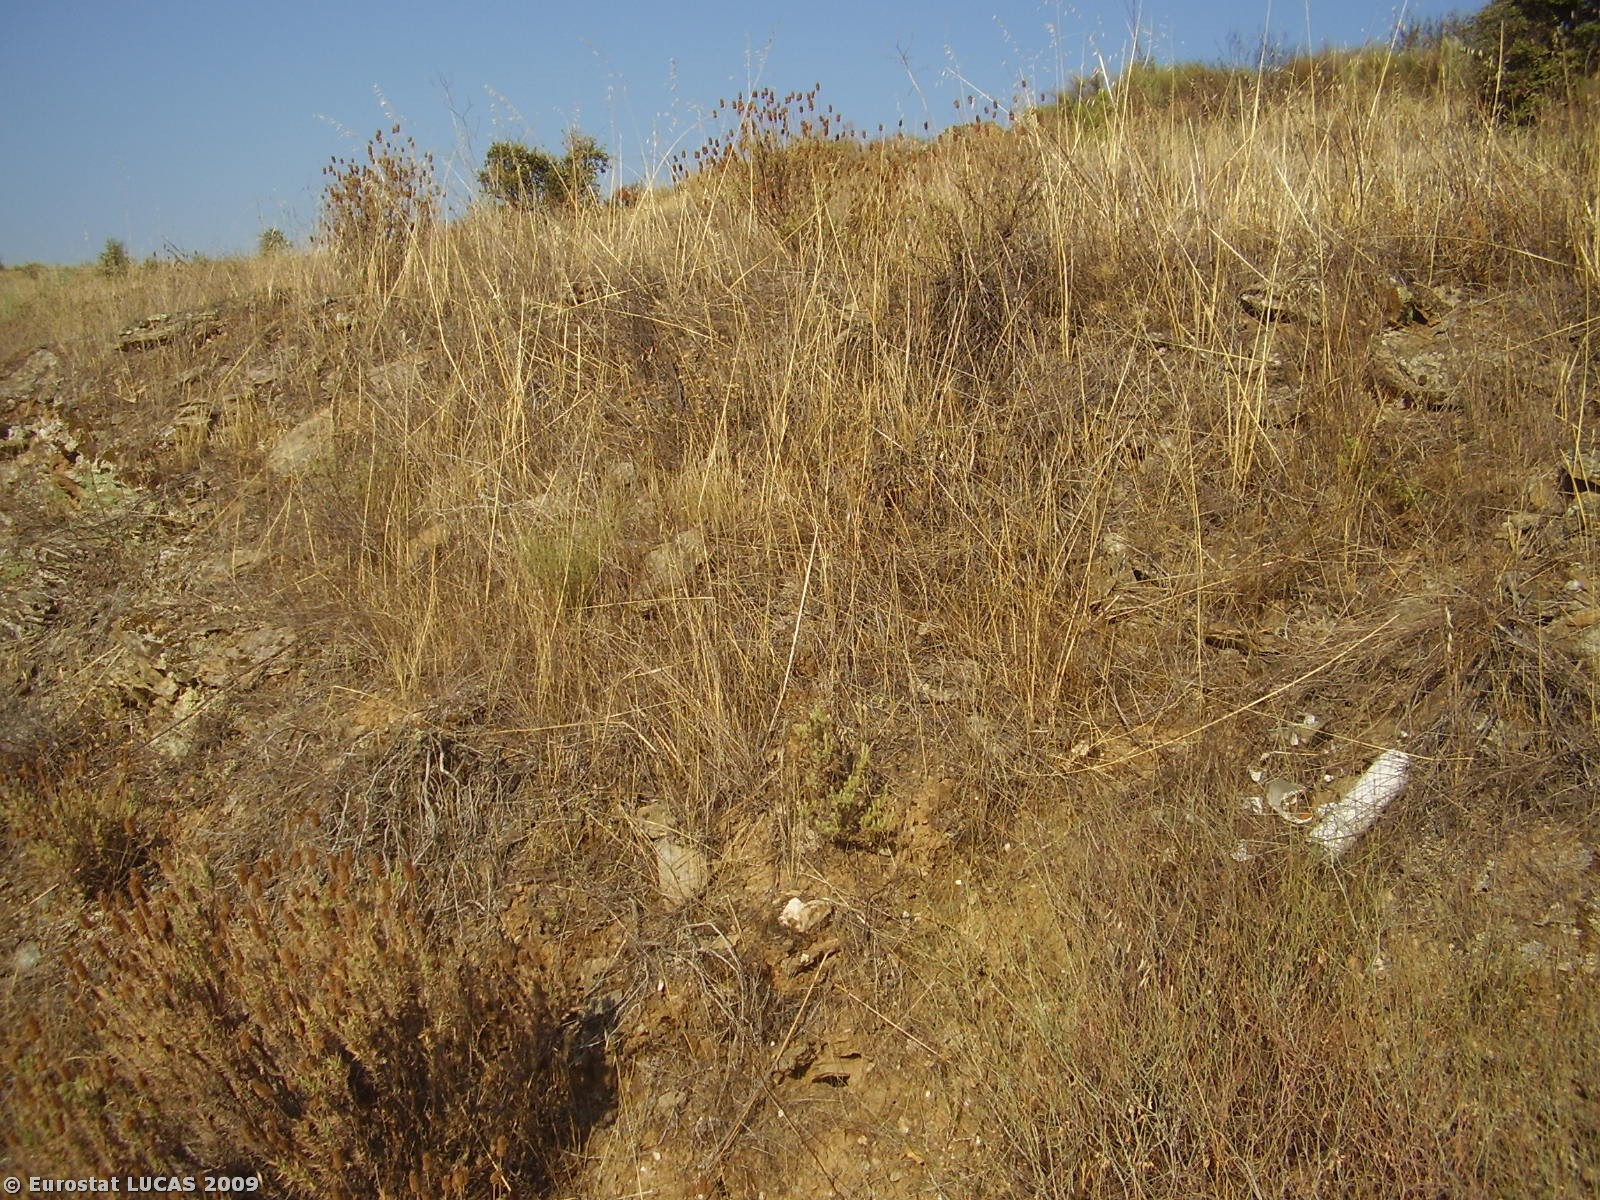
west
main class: Grassland
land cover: Spontaneously vegetated surfaces
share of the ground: > 75 %
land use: Fallow land
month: August
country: PT
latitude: 41.3652
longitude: -7.0291
